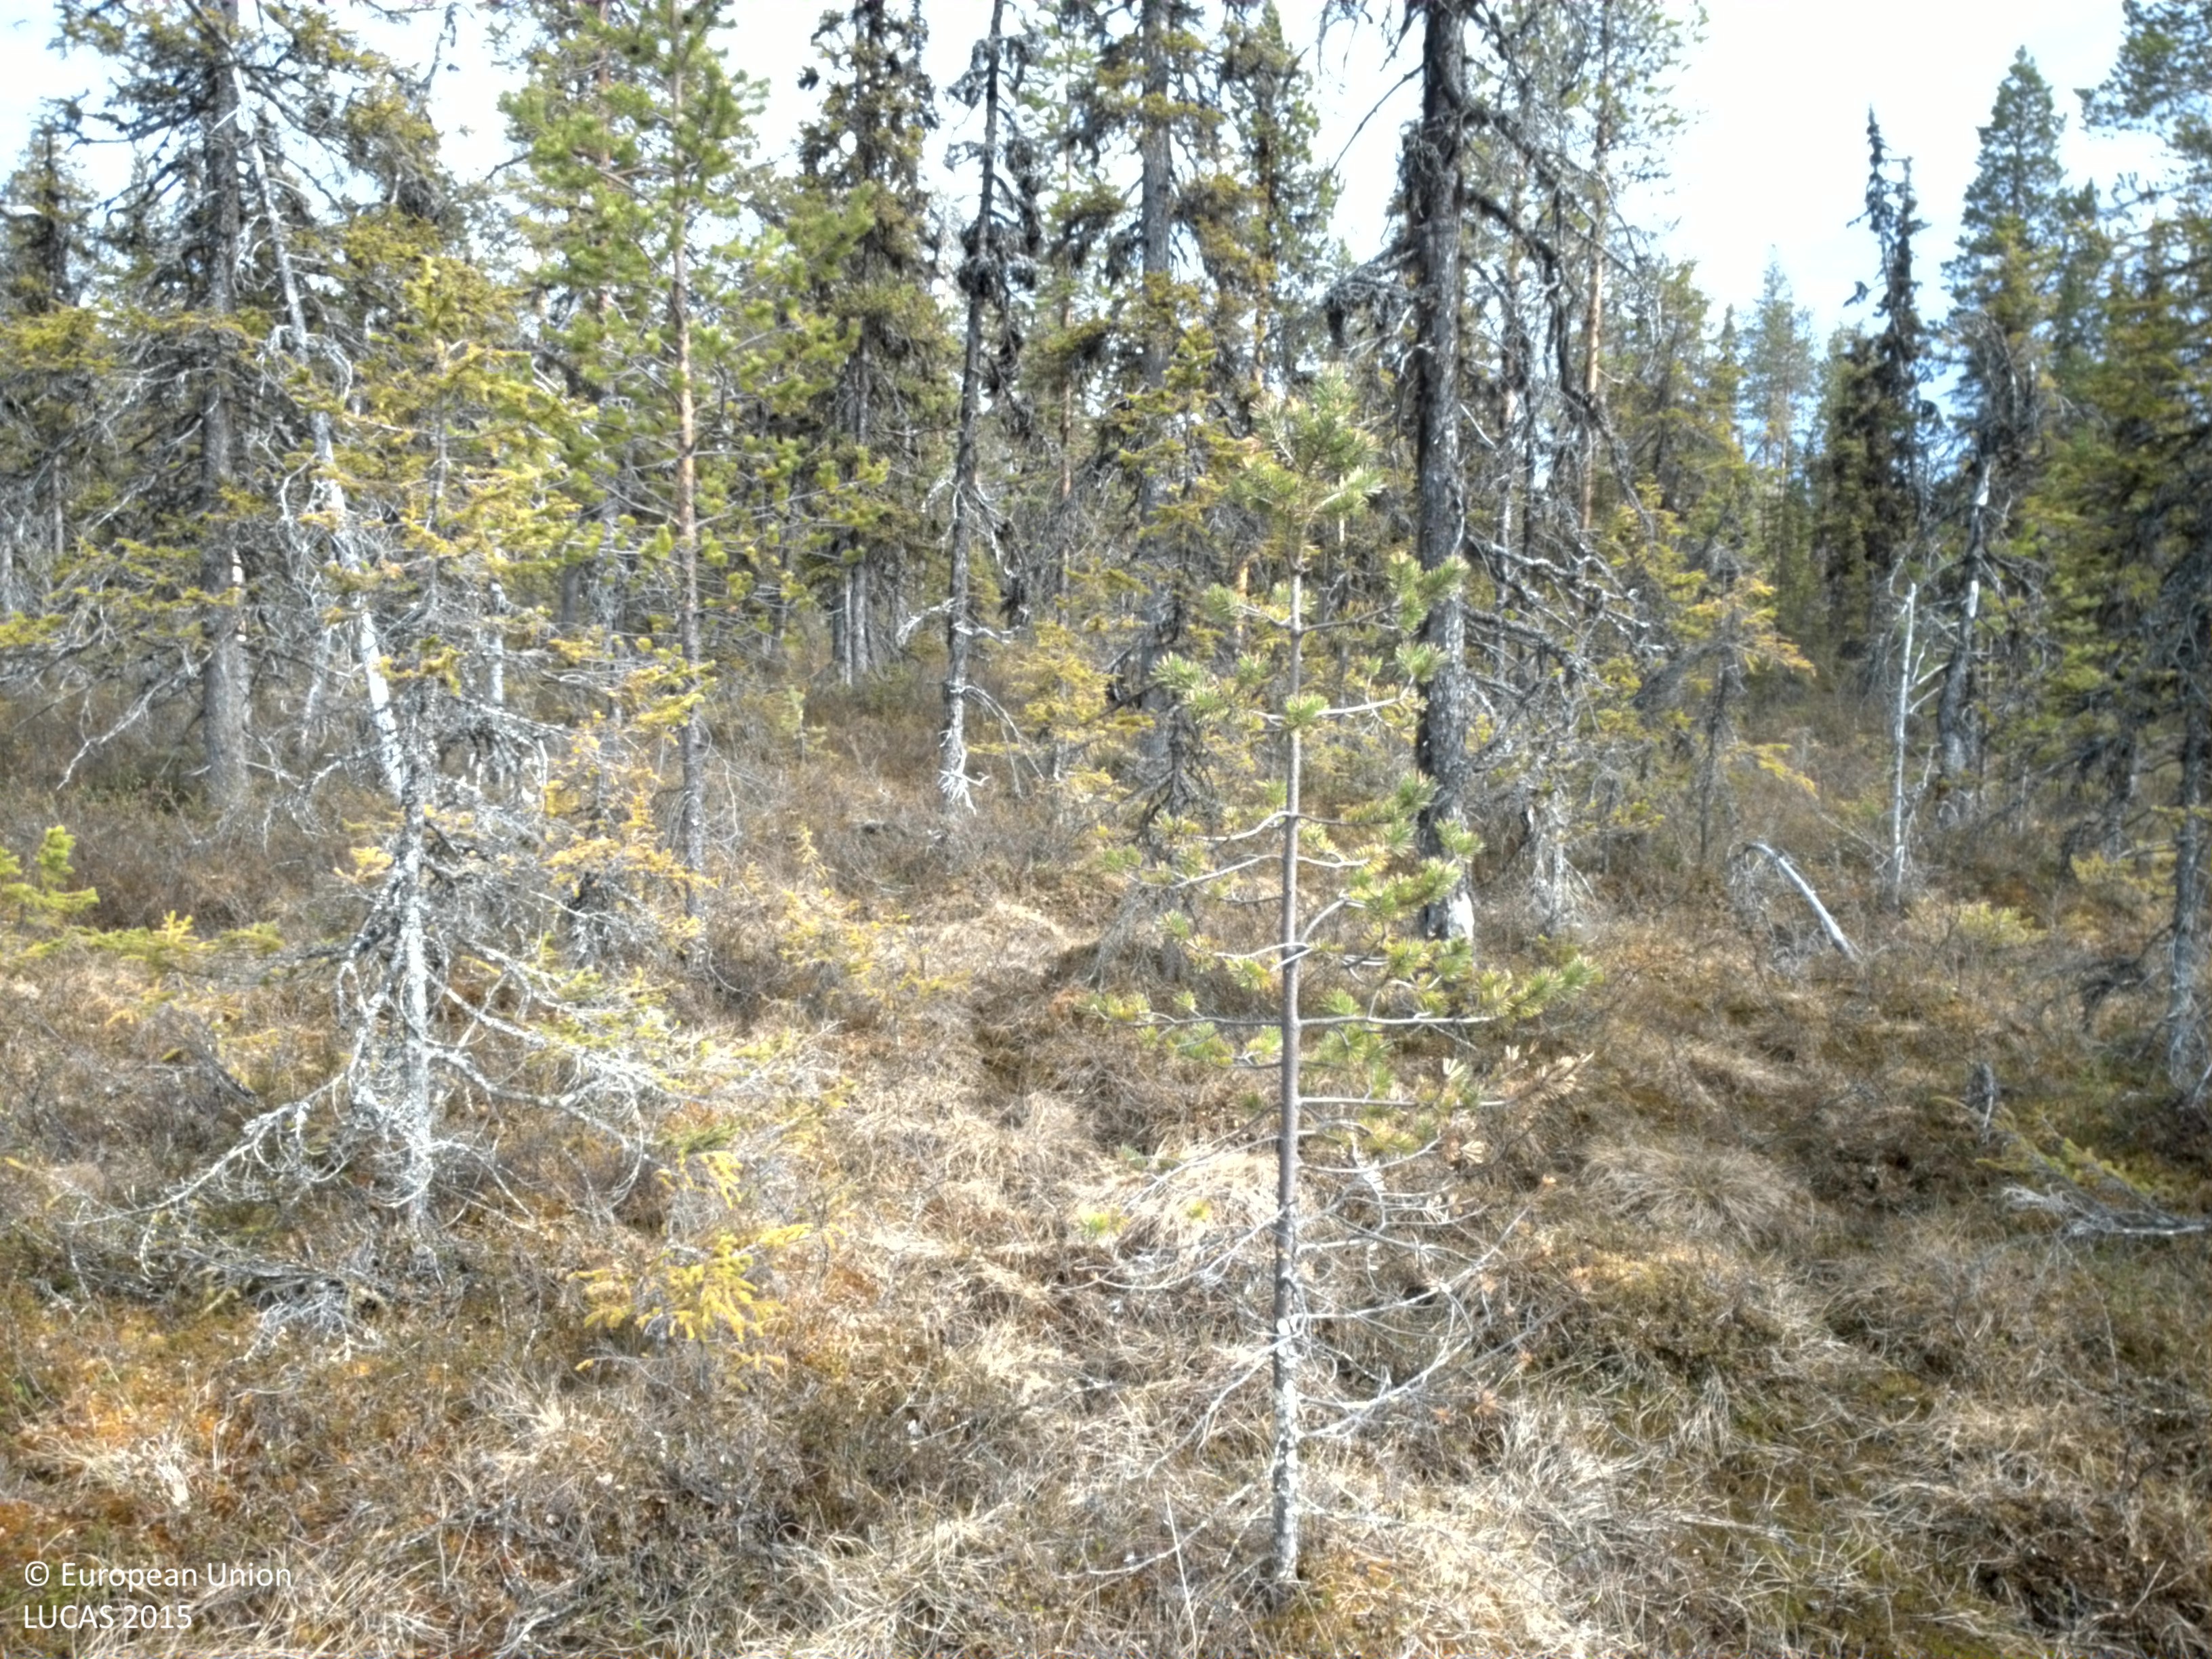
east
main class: Woodland
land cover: Spruce dominated coniferous woodland
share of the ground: 10 - 25 %
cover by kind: shrubs 60 %, herbaceous plants 20 %, coniferous forest trees 15 %, lichens and mosses 5 %
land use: Semi-natural and natural areas not in use
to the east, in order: Spruce dominated coniferous woodland; Other coniferous woodland; Spruce dominated coniferous woodland; Pine dominated coniferous woodland; Other mixed woodland
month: June
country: SE
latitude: 66.1741
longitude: 18.8060
